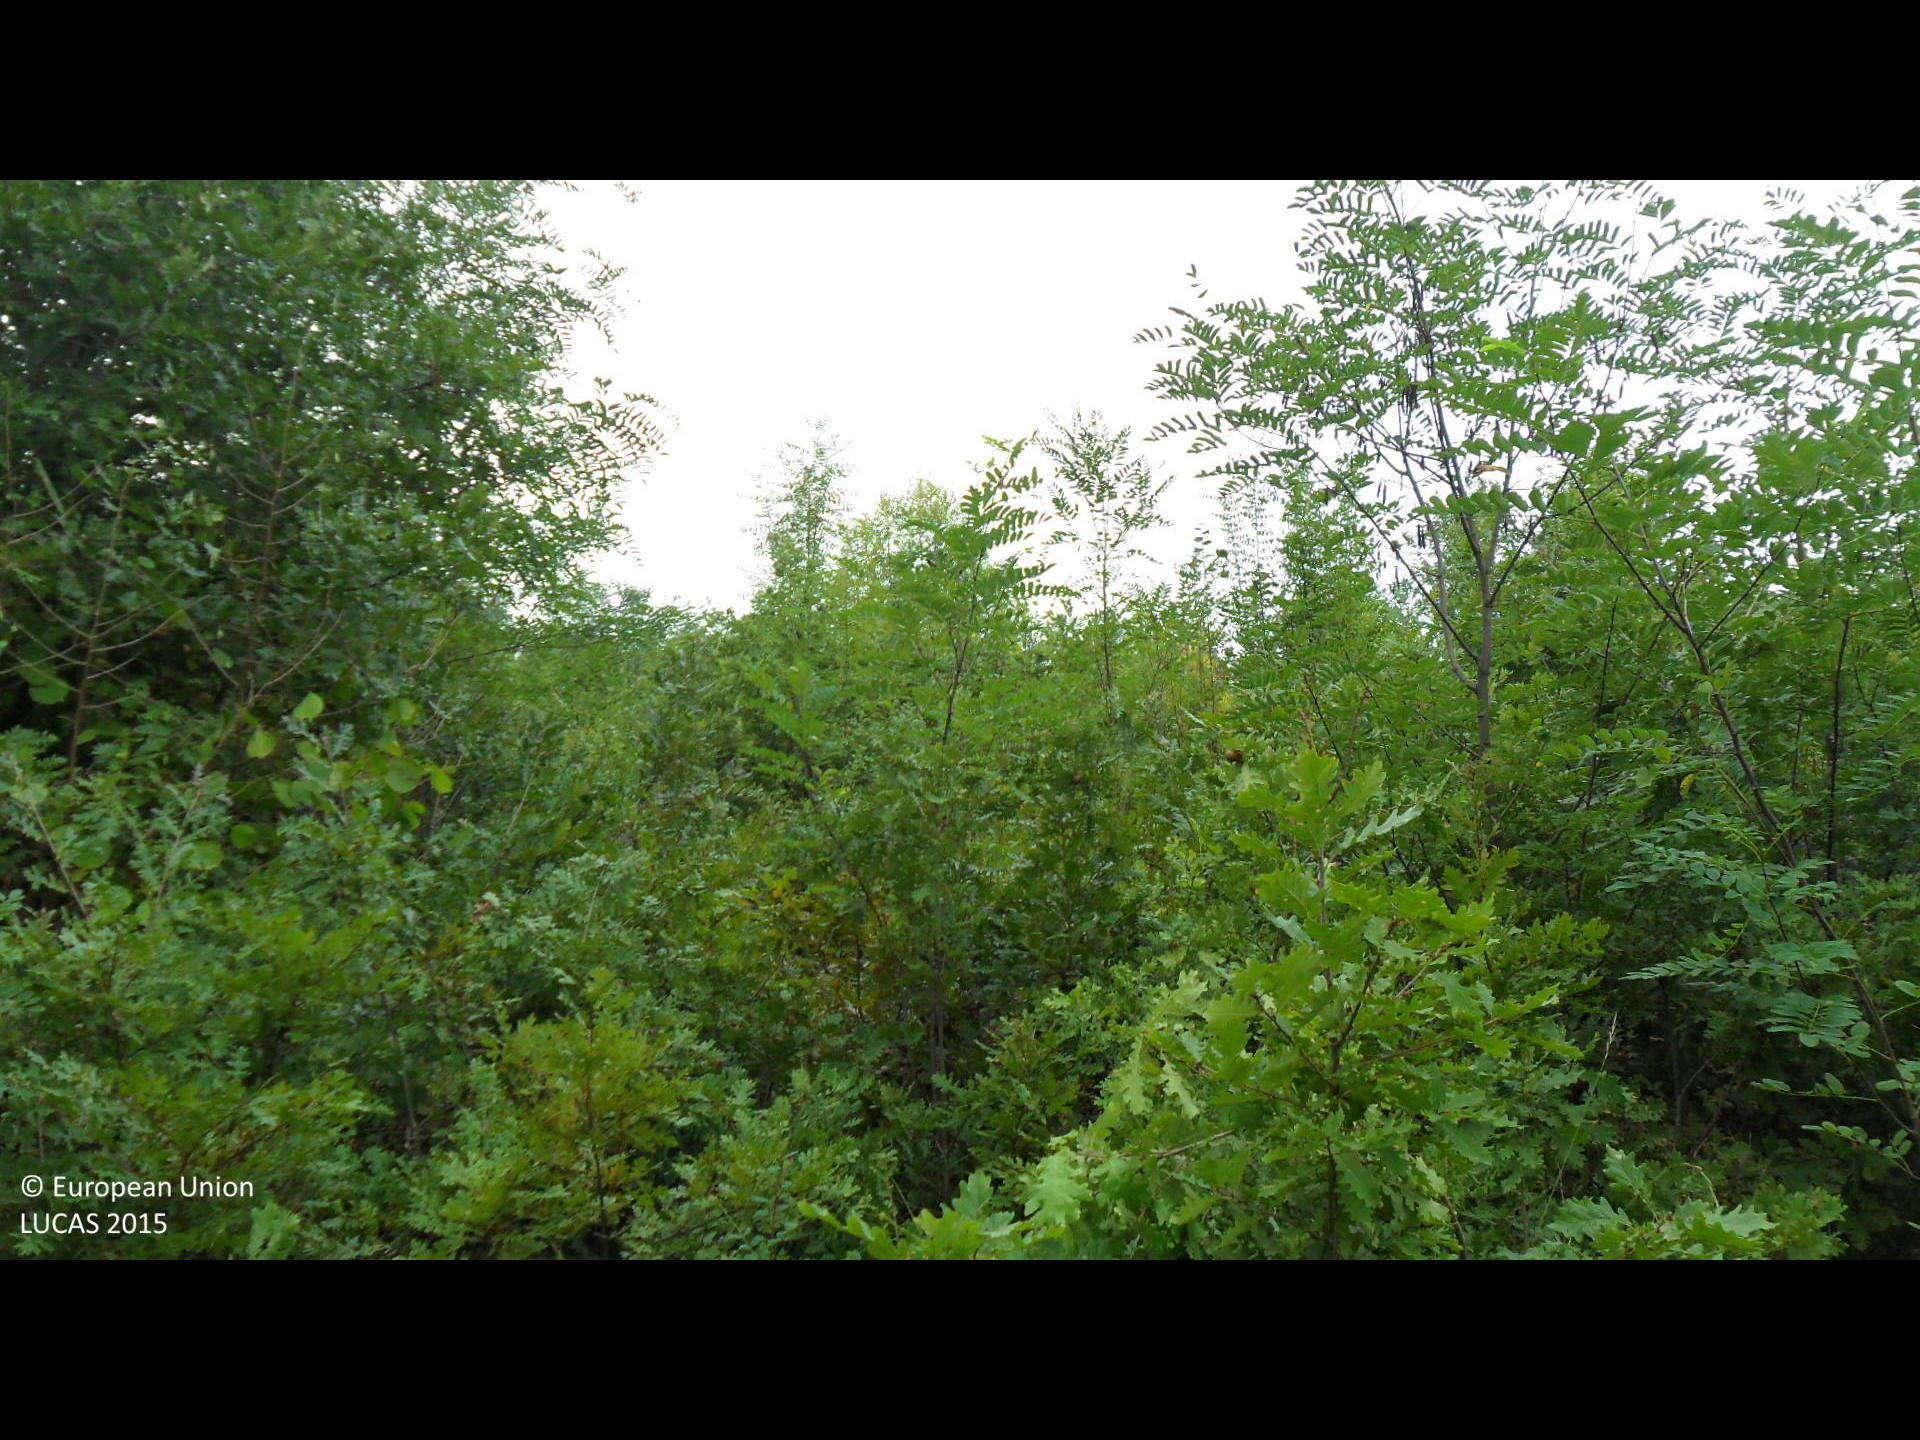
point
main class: Woodland
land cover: Broadleaved woodland
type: mesophytic deciduous forest
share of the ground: > 75 %
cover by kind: broadleaved forest trees 95 %, unconsolidated bare surface 5 %
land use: Forestry
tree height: > 5 m
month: September
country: BG
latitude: 43.1136
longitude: 26.2547
